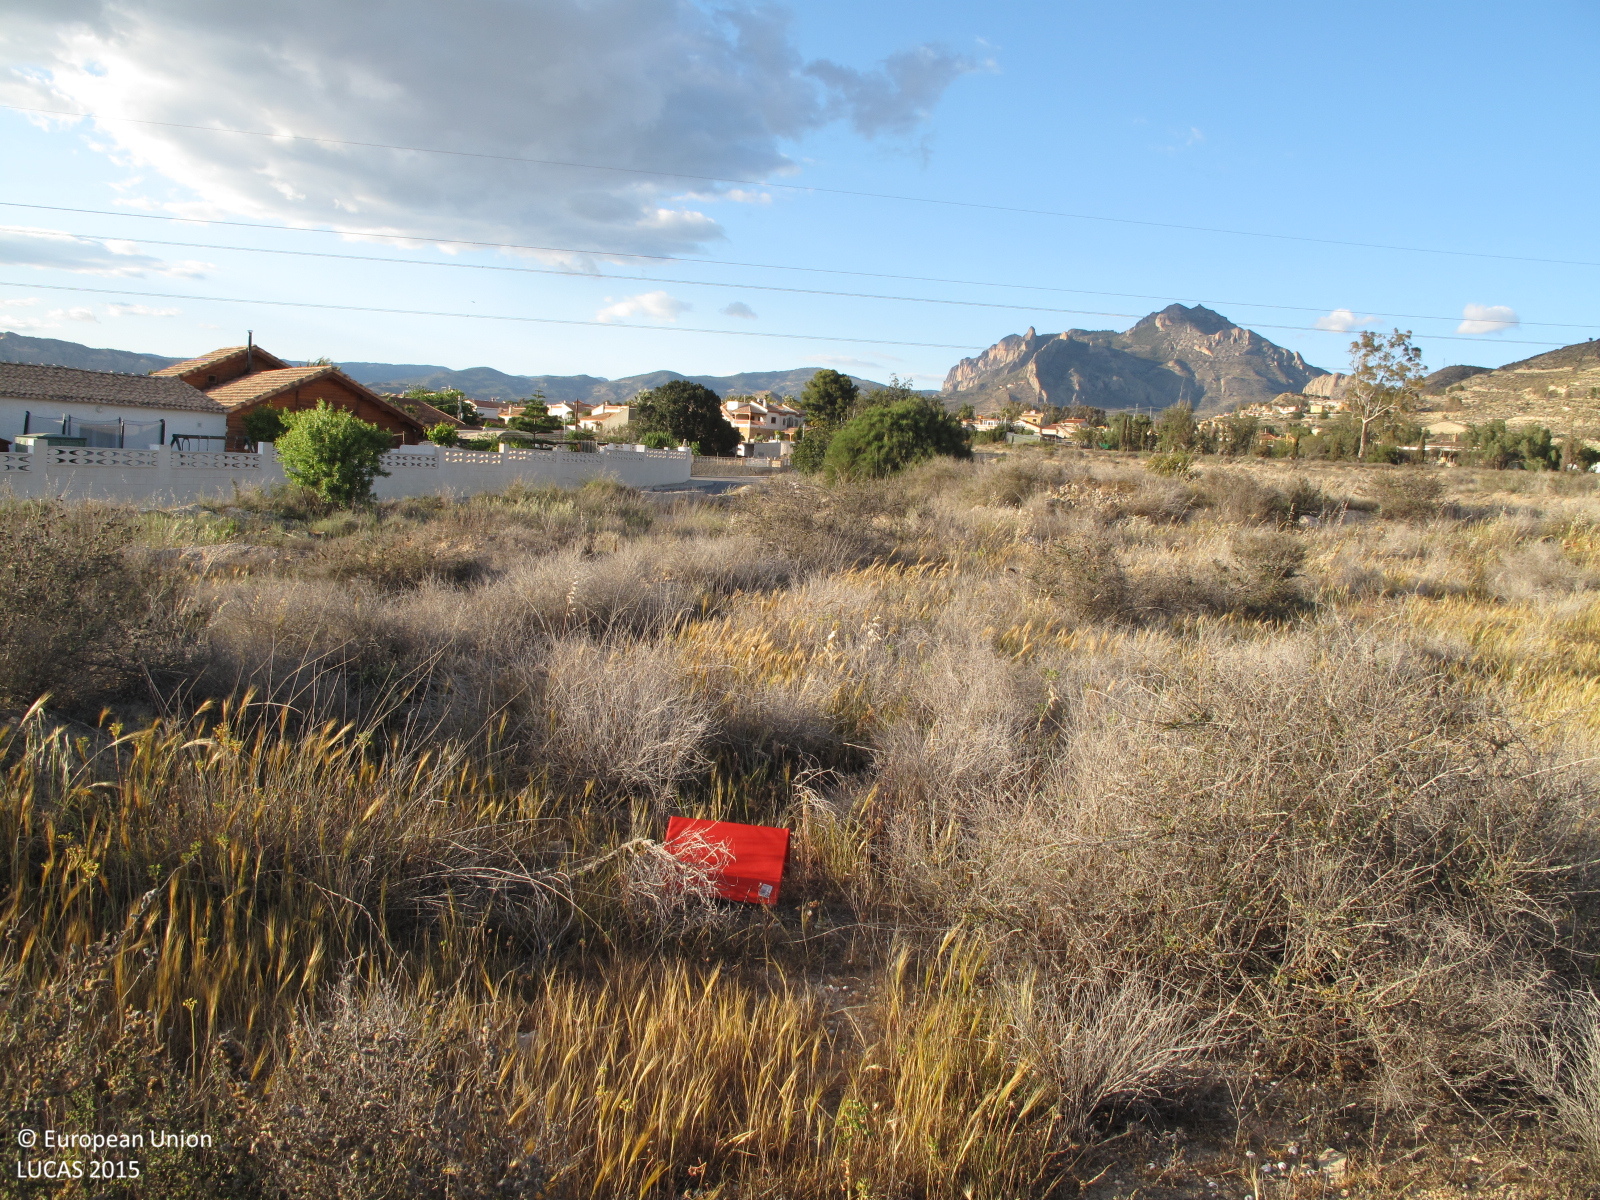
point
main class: Shrubland
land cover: Shrubland without tree cover
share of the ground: 25 - 50 %
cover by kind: herbaceous plants 60 %, shrubs 30 %, consolidated bare surface 10 %
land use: Semi-natural and natural areas not in use
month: April
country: ES
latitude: 38.4695
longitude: -0.4281
